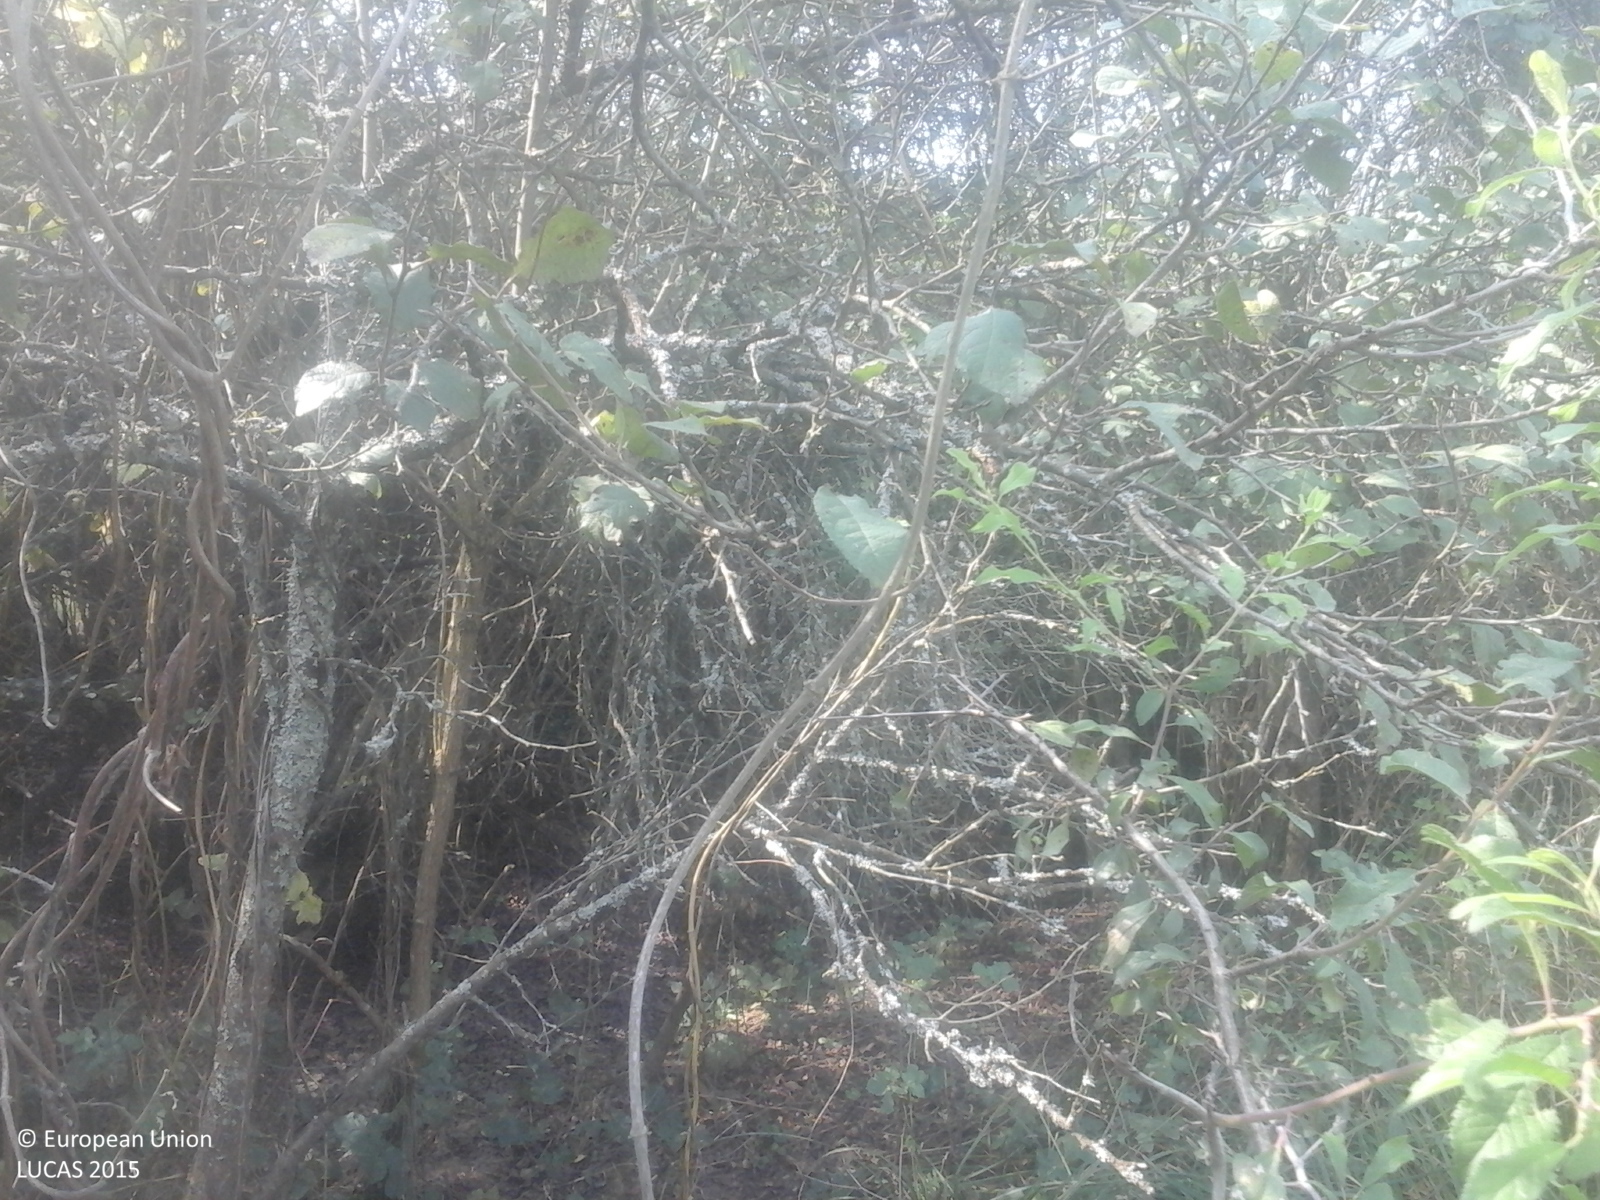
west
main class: Shrubland
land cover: Shrubland with sparse tree cover
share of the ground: > 75 %
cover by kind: shrubs 95 %, broadleaved forest trees 5 %
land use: Forestry
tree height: < 5 m
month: September
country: RO
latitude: 45.8191
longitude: 22.1537
